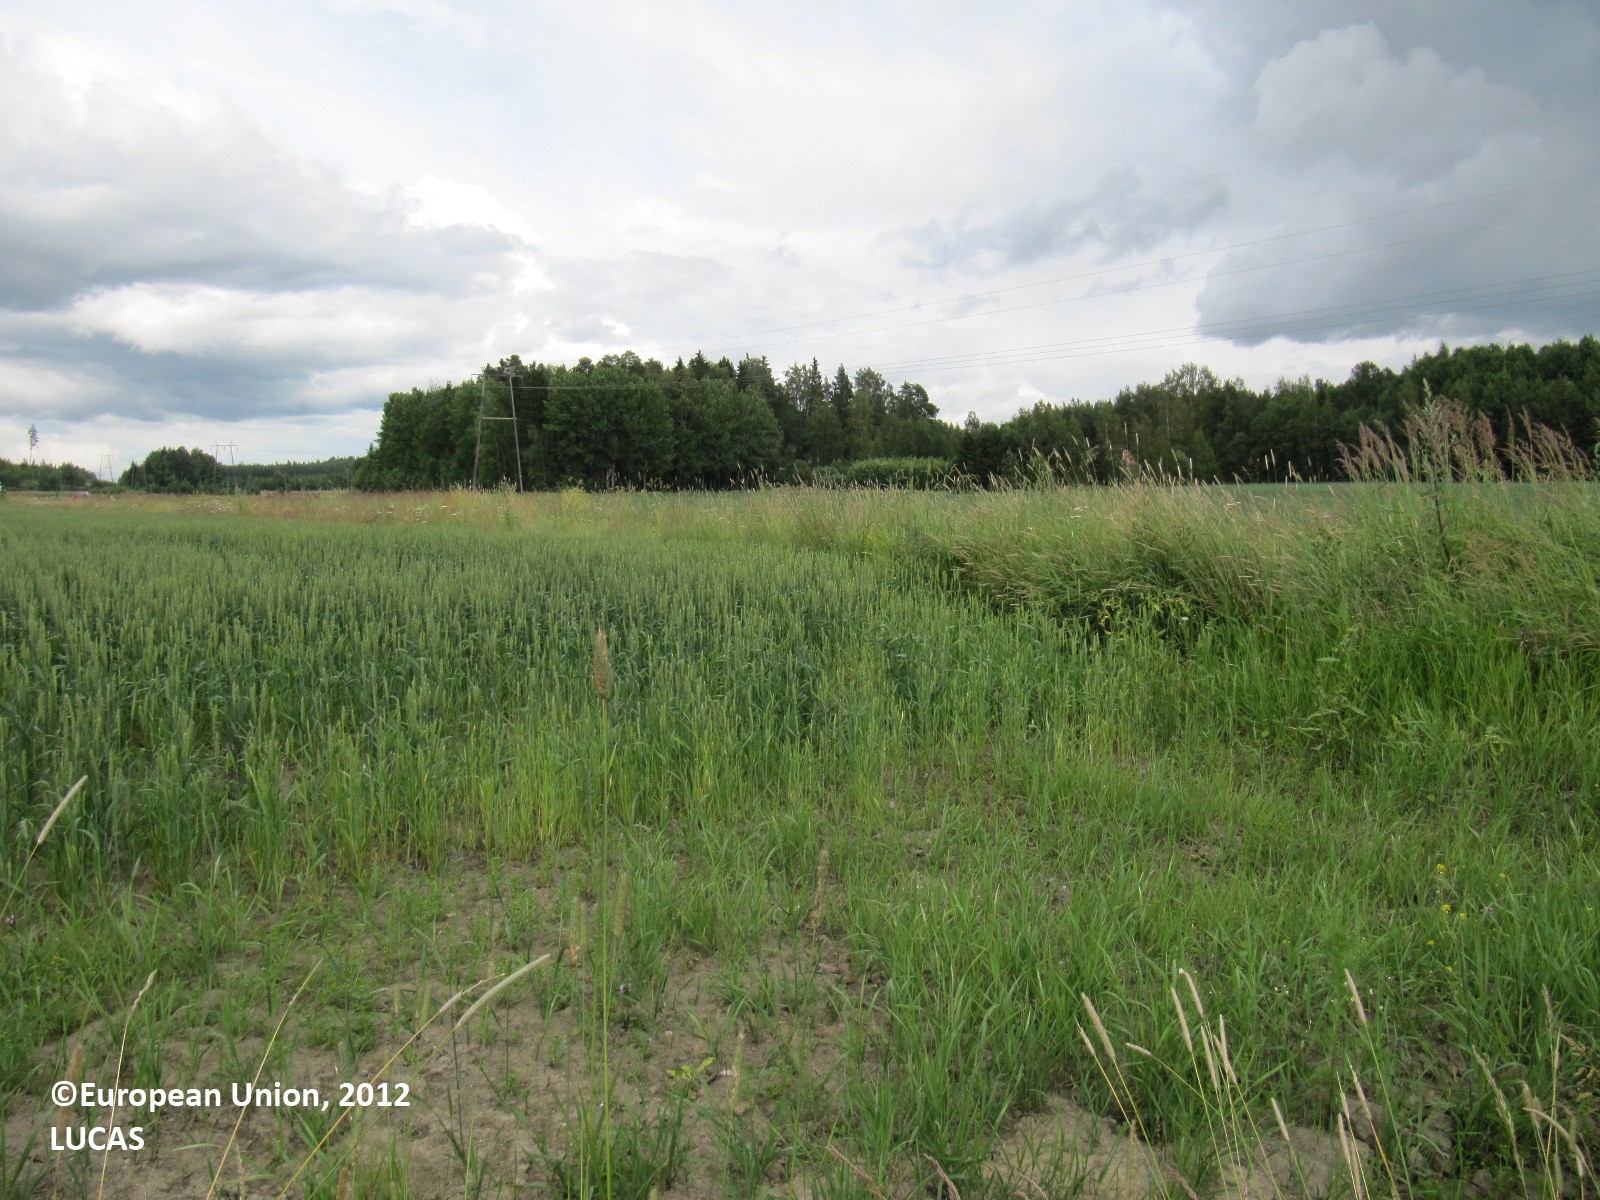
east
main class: Grassland
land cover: Spontaneously vegetated surfaces
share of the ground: > 75 %
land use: Semi-natural and natural areas not in use
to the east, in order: Ditches and canals; Spontaneously vegetated surfaces; Common wheat; Grass margins; Paved roads, cycling and walking lanes; Grass margins; Oats; Electric lines; Oats; Grassland with sparse tree/shrub cover
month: July
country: FI
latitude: 60.8235
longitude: 24.6528
